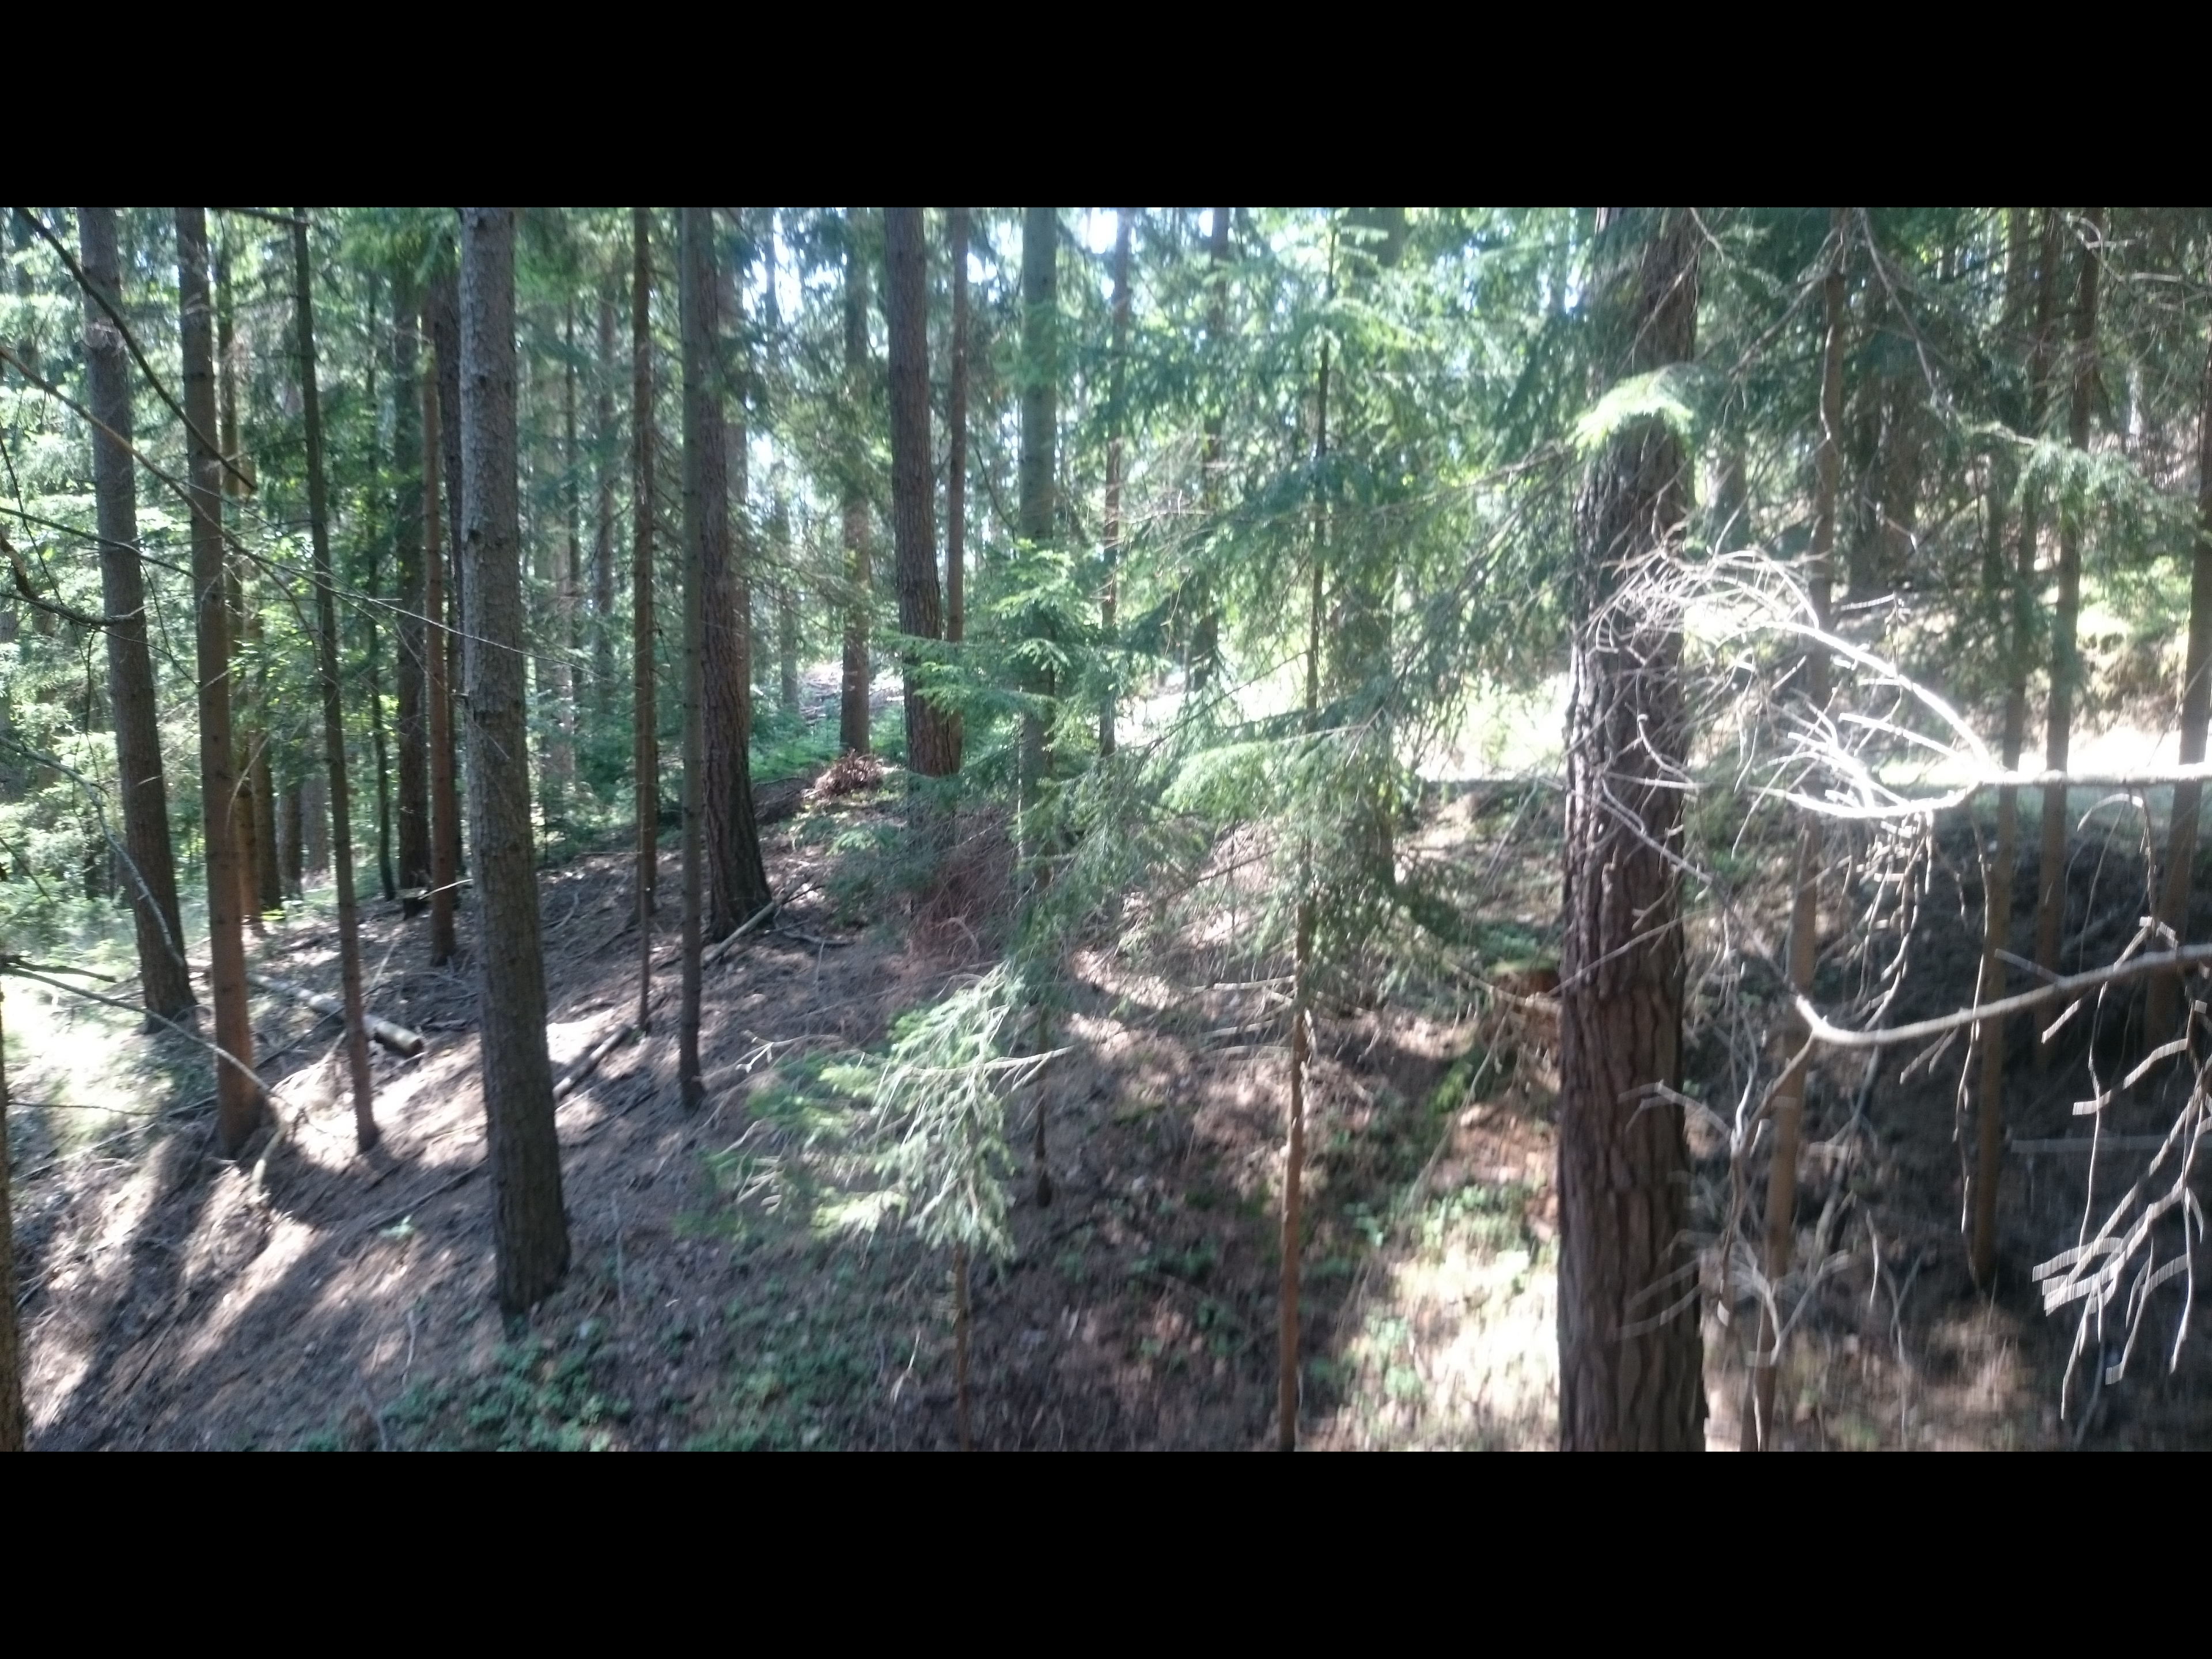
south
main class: Woodland
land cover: Spruce dominated coniferous woodland
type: hemiboreal forest and nemoral coniferous forest and mixed broadleaved-coniferous forest
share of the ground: > 75 %
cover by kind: coniferous forest trees 90 %, consolidated bare surface 10 %
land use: Forestry
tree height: > 5 m
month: July
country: AT
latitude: 47.2021
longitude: 15.5051
